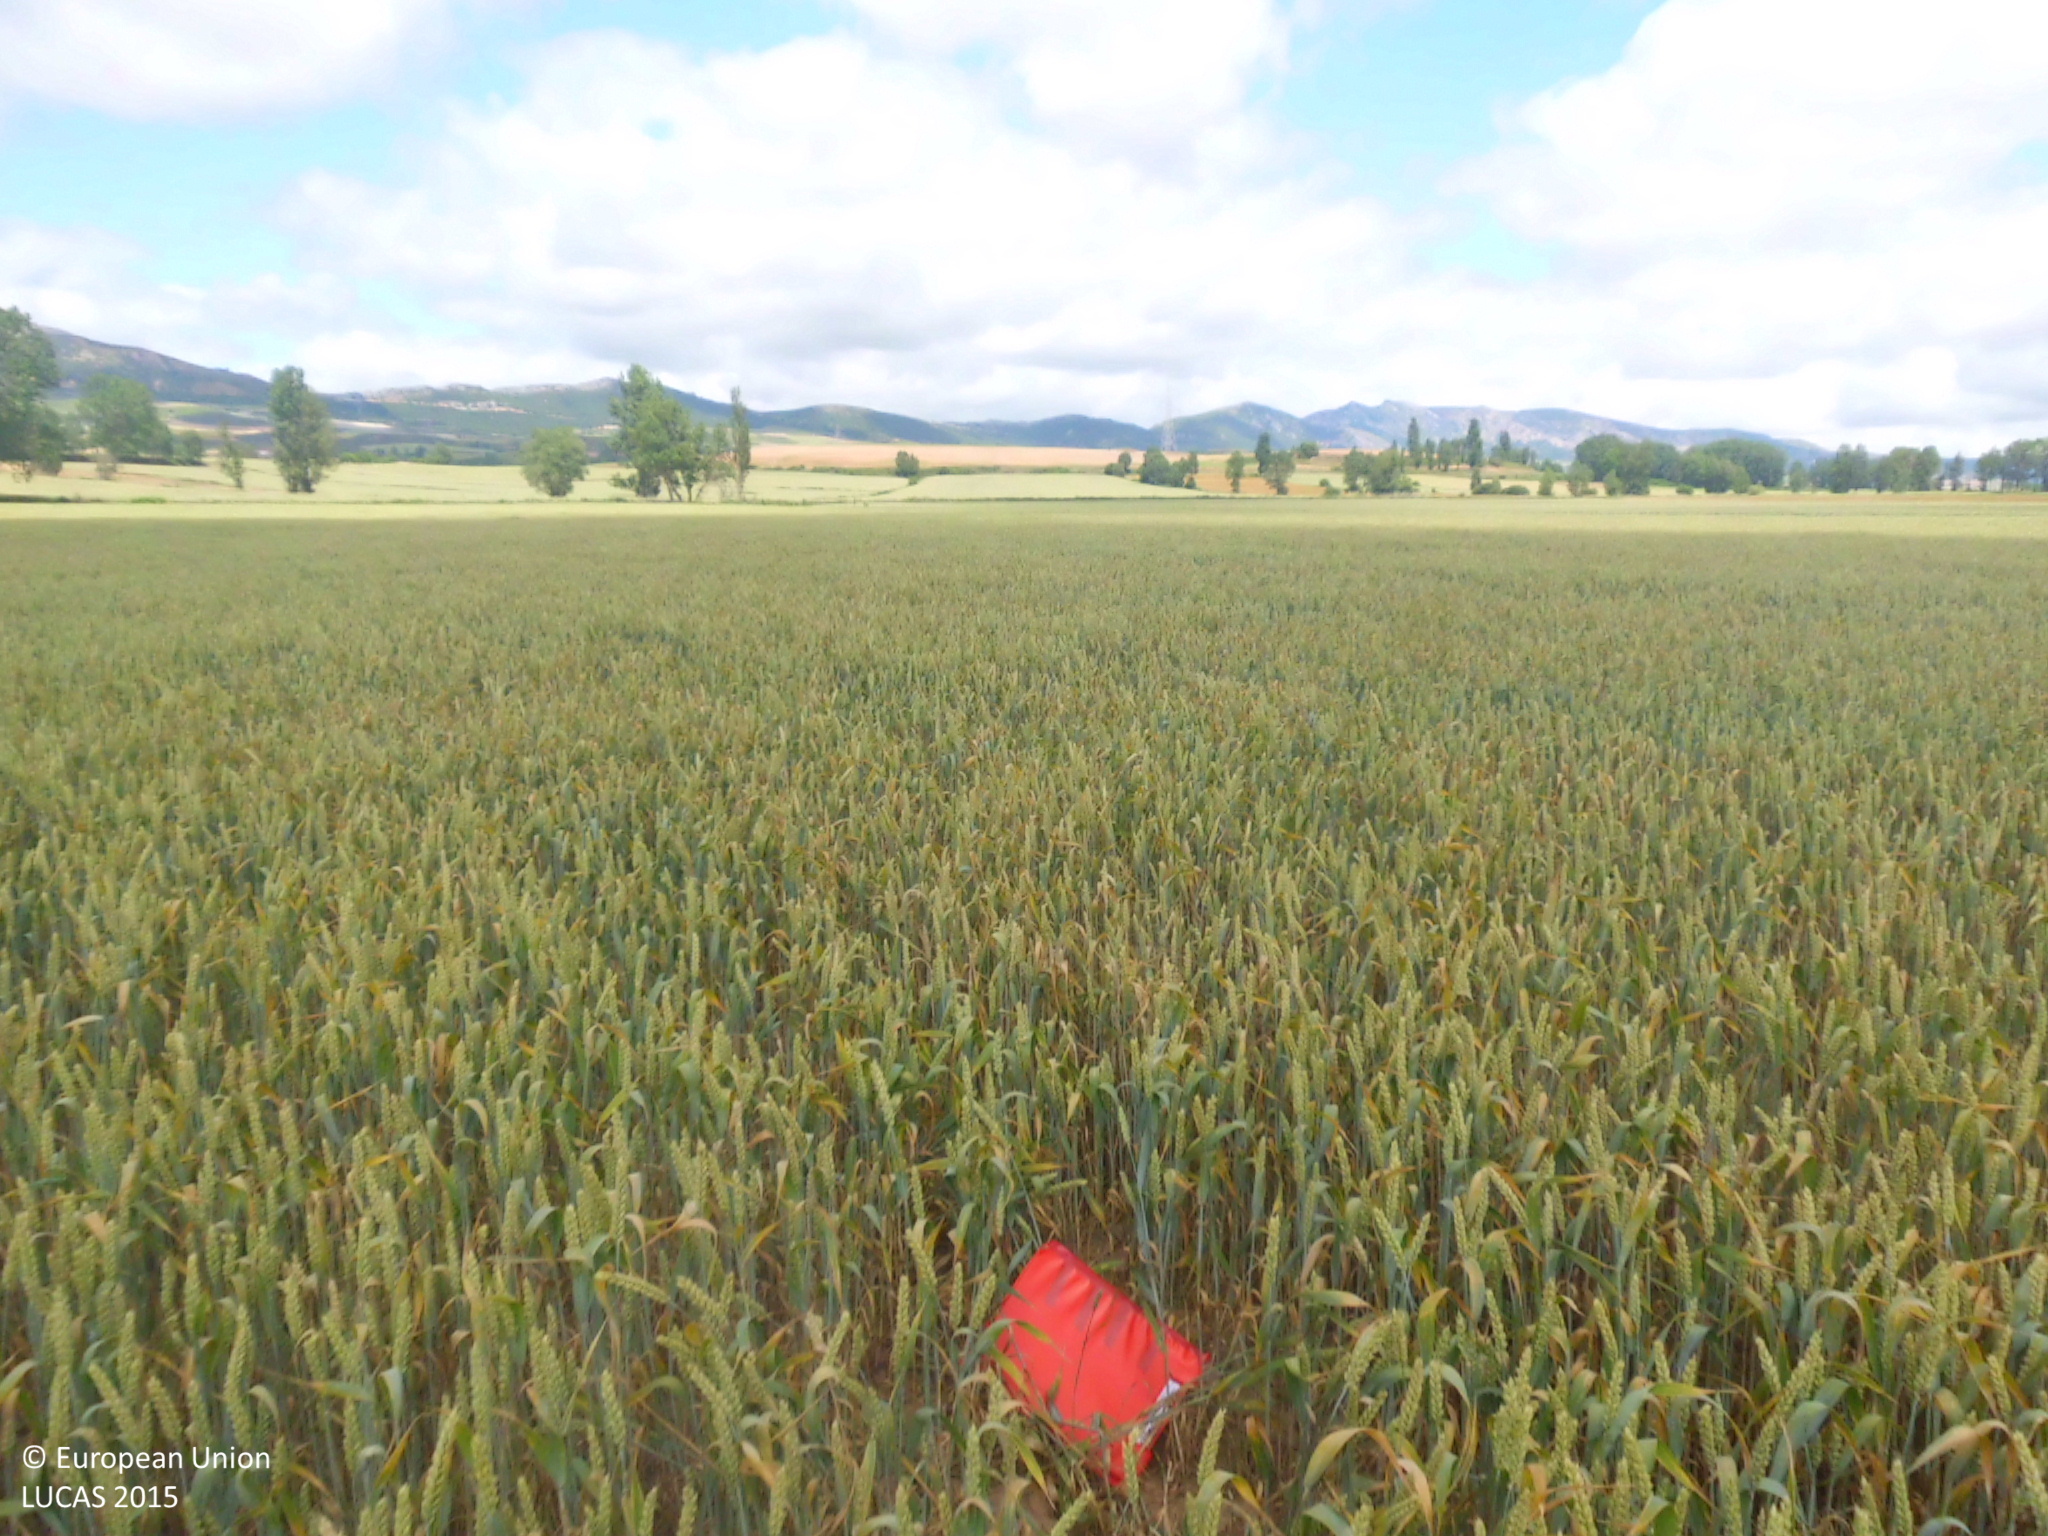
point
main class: Cropland
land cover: Common wheat
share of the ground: > 75 %
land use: Agriculture (excluding fallow land and kitchen gardens)
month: June
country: ES
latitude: 42.6508
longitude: -3.2925
